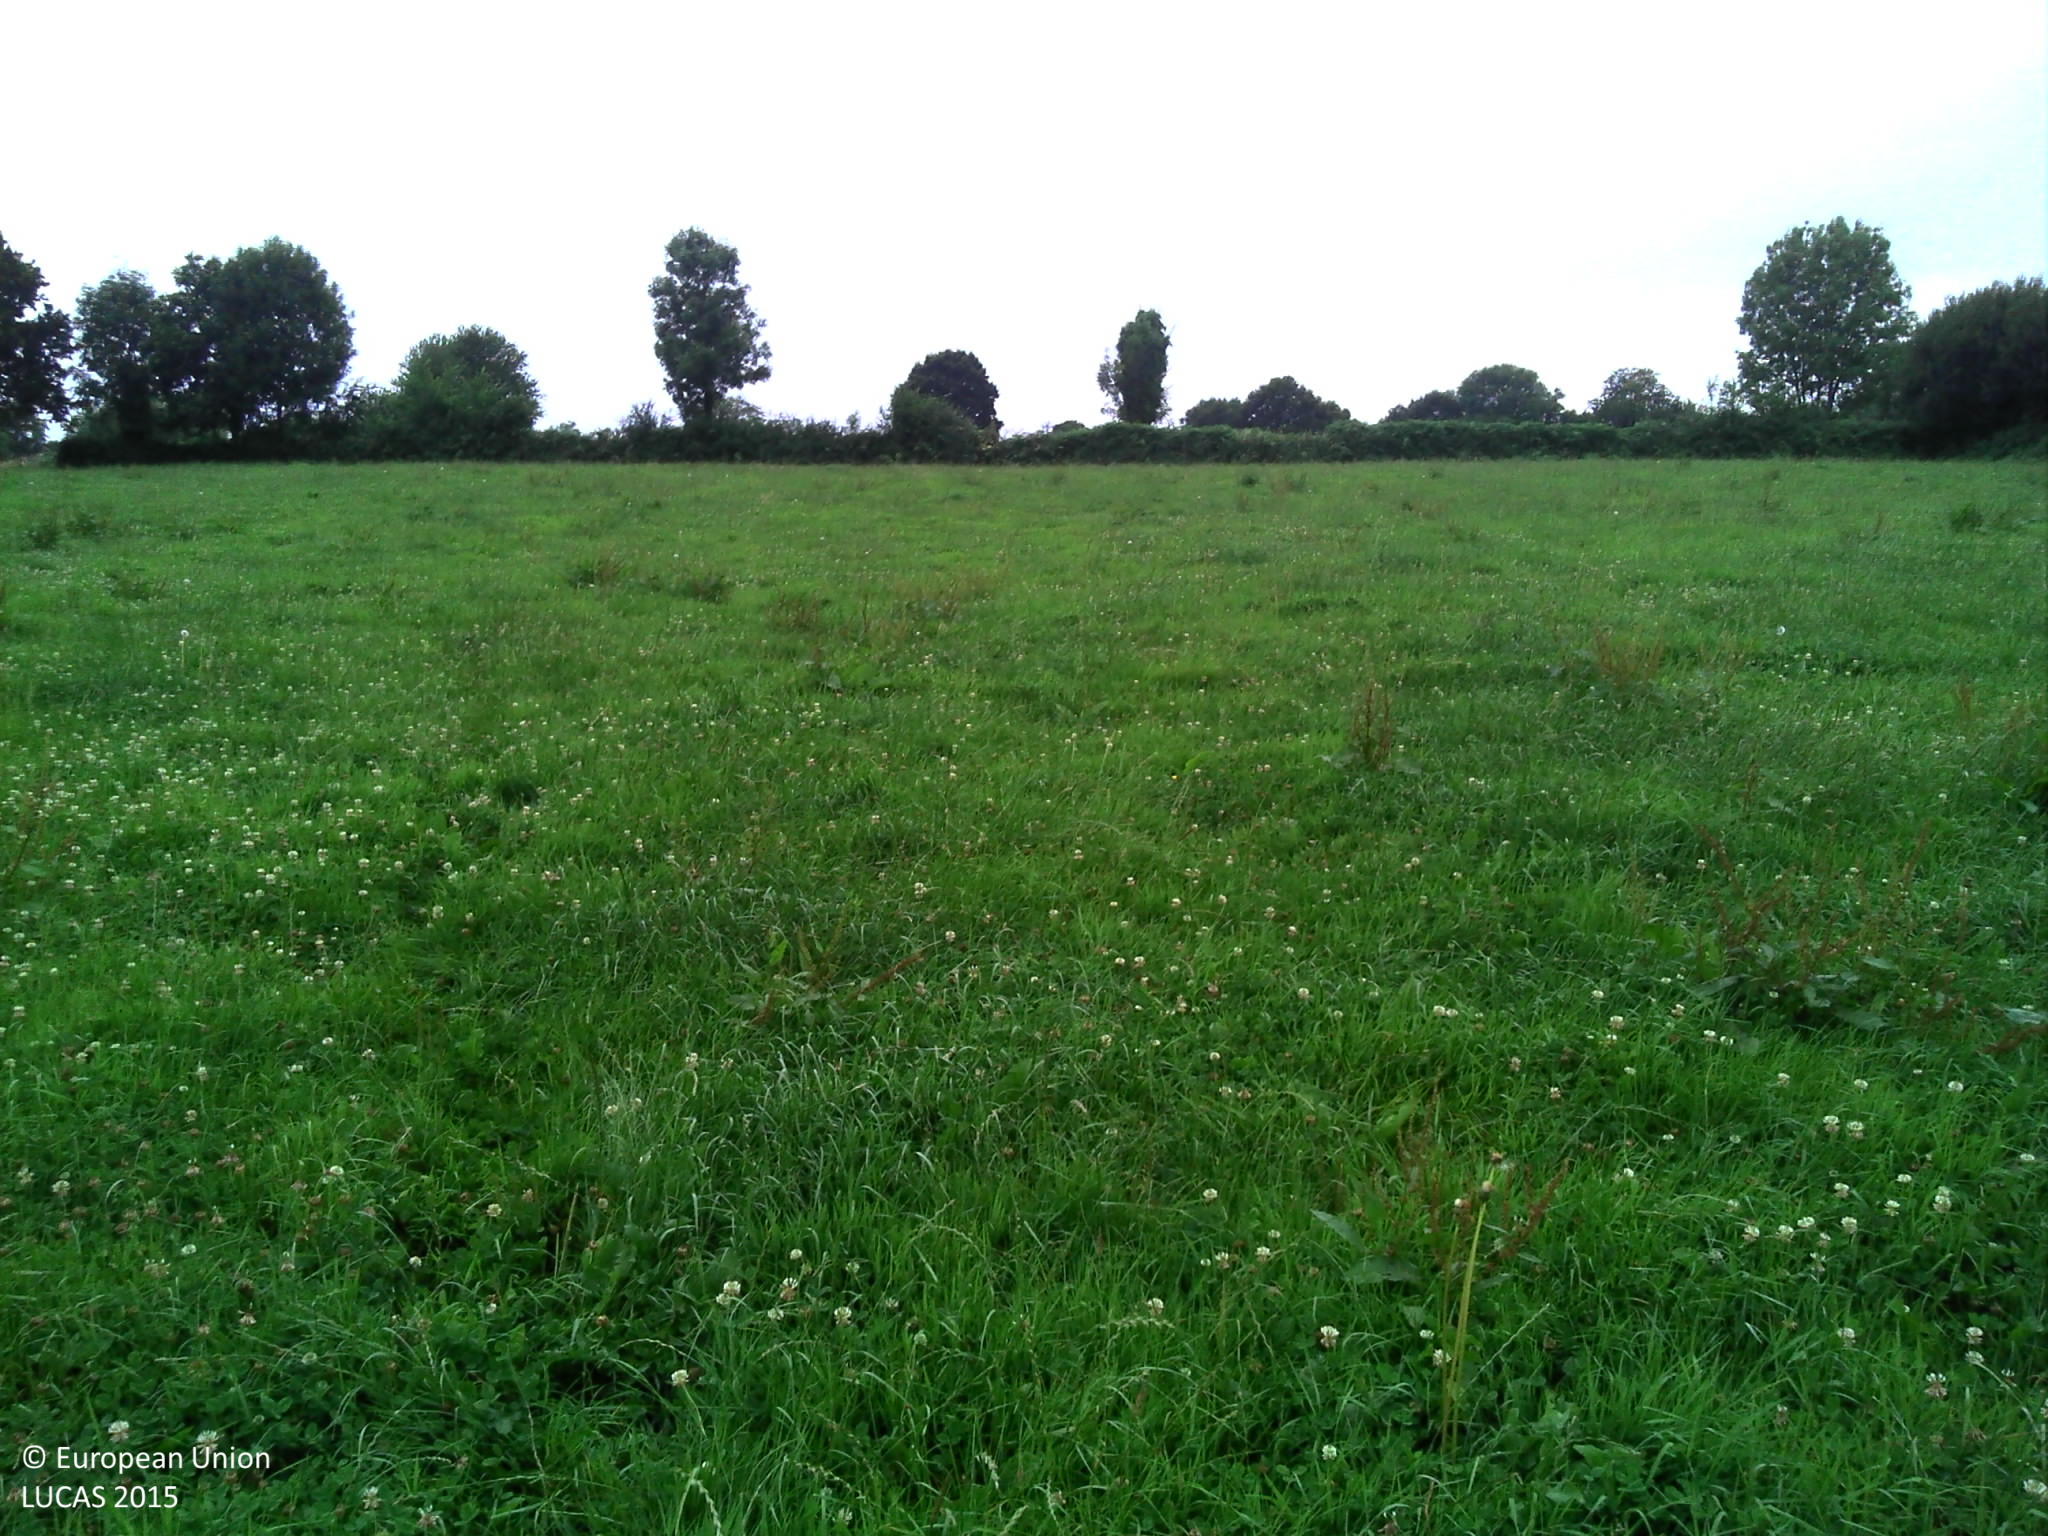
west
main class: Grassland
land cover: Grassland without tree/shrub cover
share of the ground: > 75 %
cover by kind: herbaceous plants 100 %
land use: Agriculture (excluding fallow land and kitchen gardens)
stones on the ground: < 10 %
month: July
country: FR
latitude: 48.8503
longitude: -1.3712
